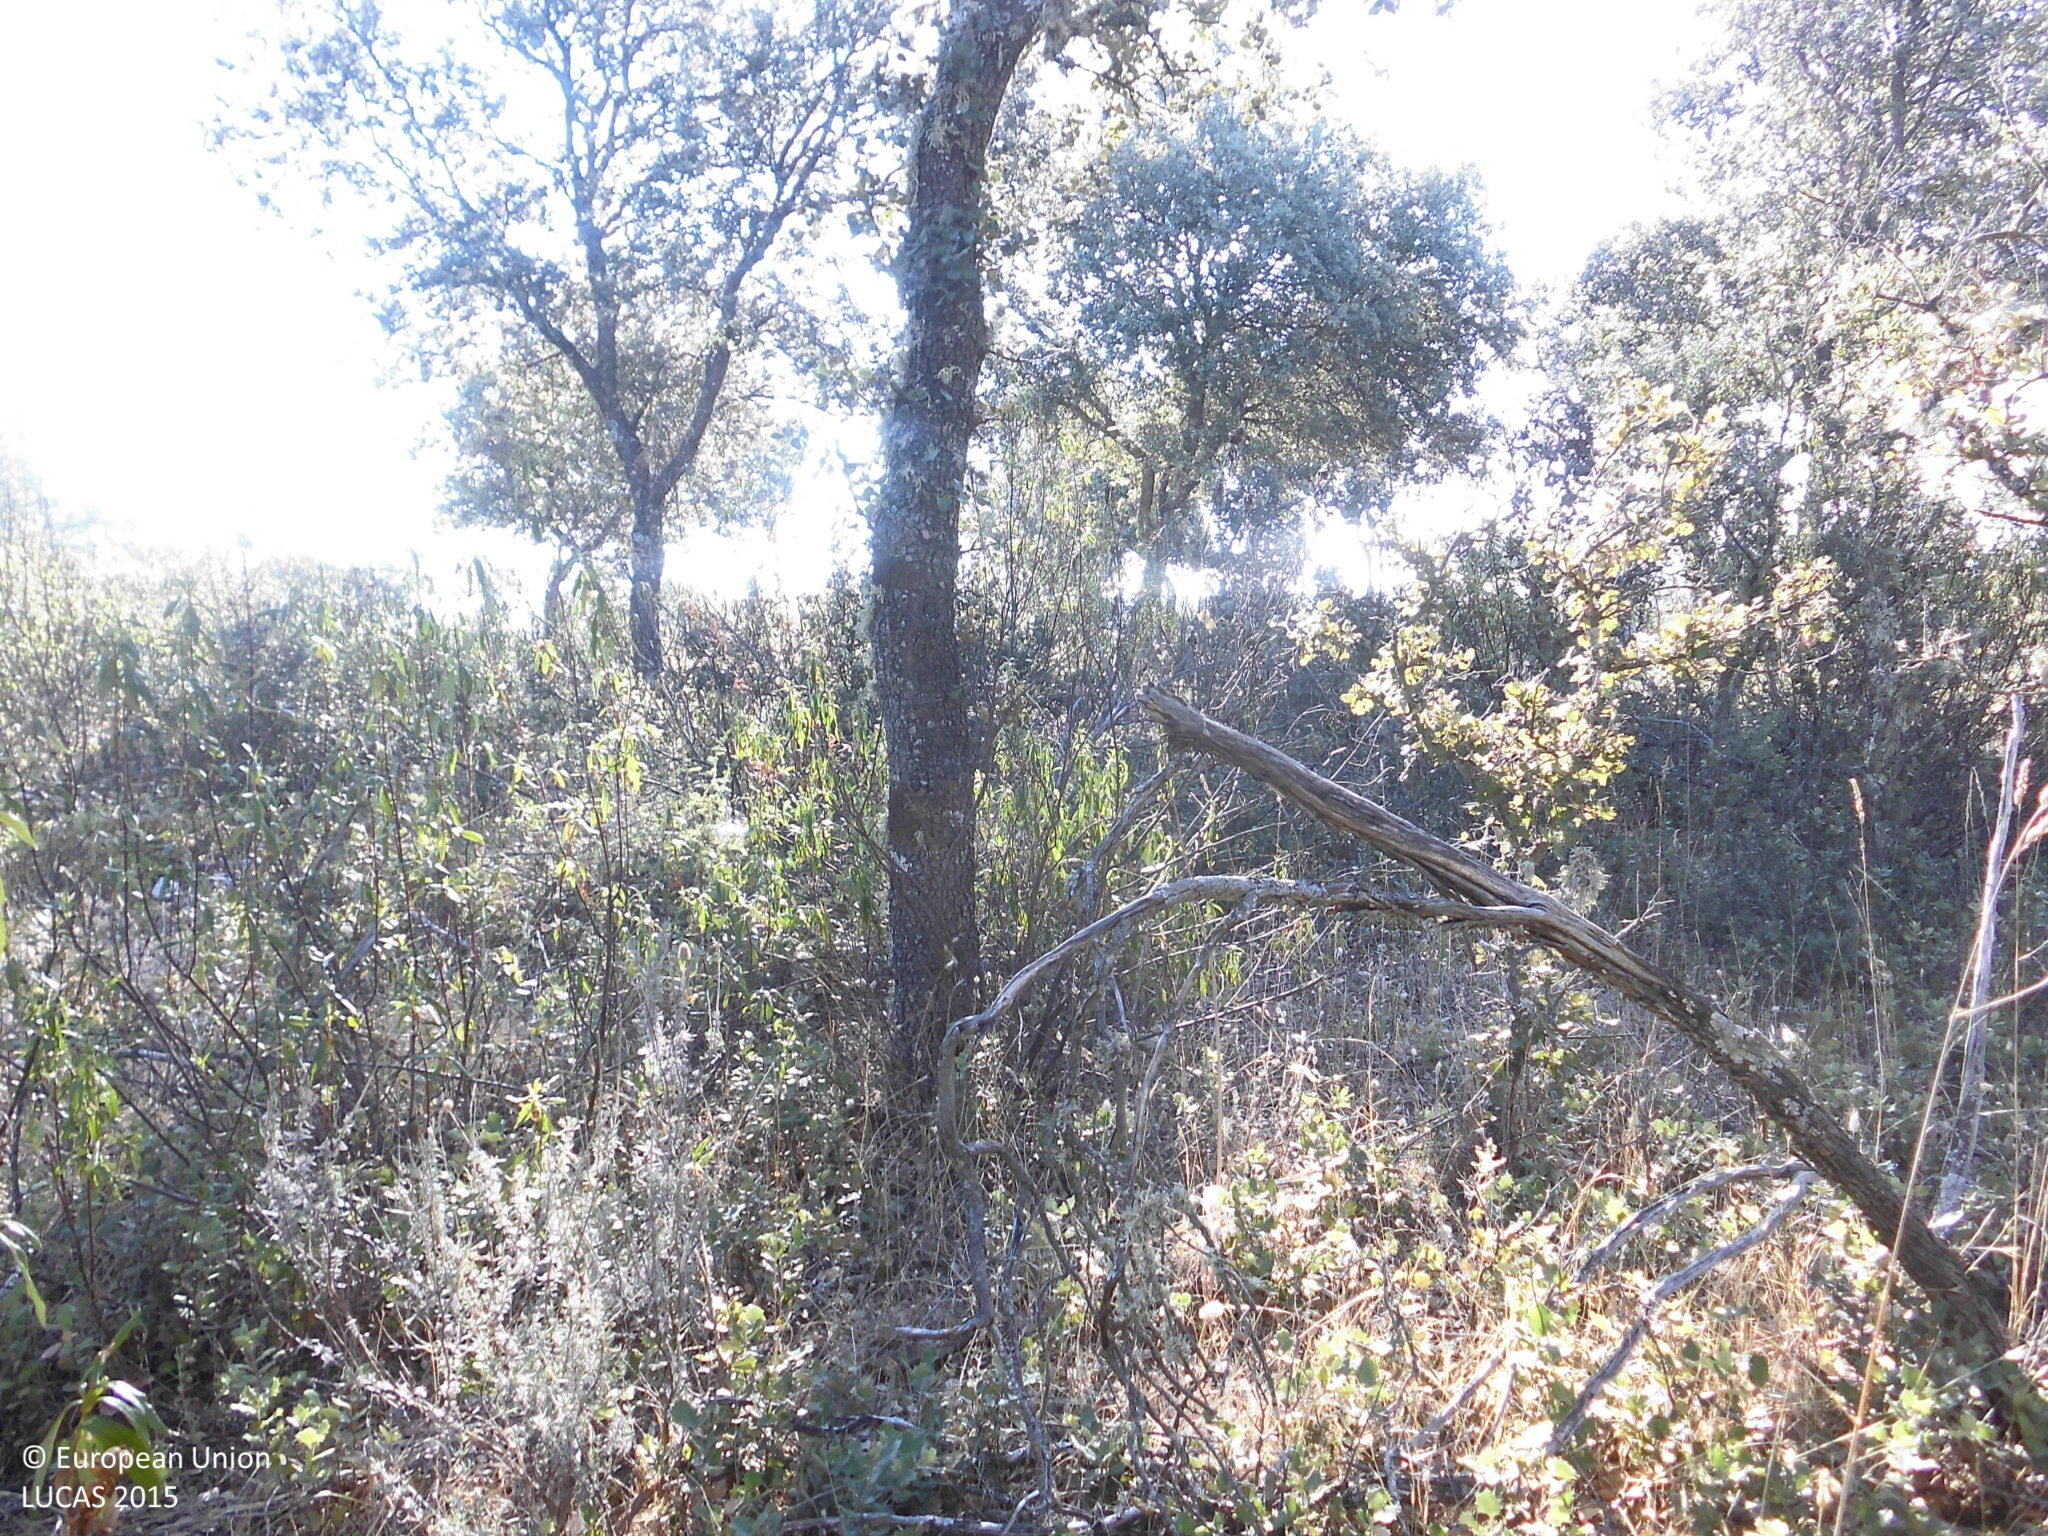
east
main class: Woodland
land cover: Broadleaved woodland
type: broadleaved evergreen forest
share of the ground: 25 - 50 %
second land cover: Shrubland without tree cover
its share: 10 - 25 %
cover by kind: broadleaved forest trees 45 %, herbaceous plants 35 %, shrubs 20 %
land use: Forestry
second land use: Agriculture (excluding fallow land and kitchen gardens)
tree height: > 5 m
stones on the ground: 10 - 25 %
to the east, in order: Broadleaved woodland; Shrubland without tree cover; Broadleaved woodland; Tracks; Broadleaved woodland; Electric lines; Broadleaved woodland; Electric lines; Broadleaved woodland
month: July
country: ES
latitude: 39.7860
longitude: -5.6954
